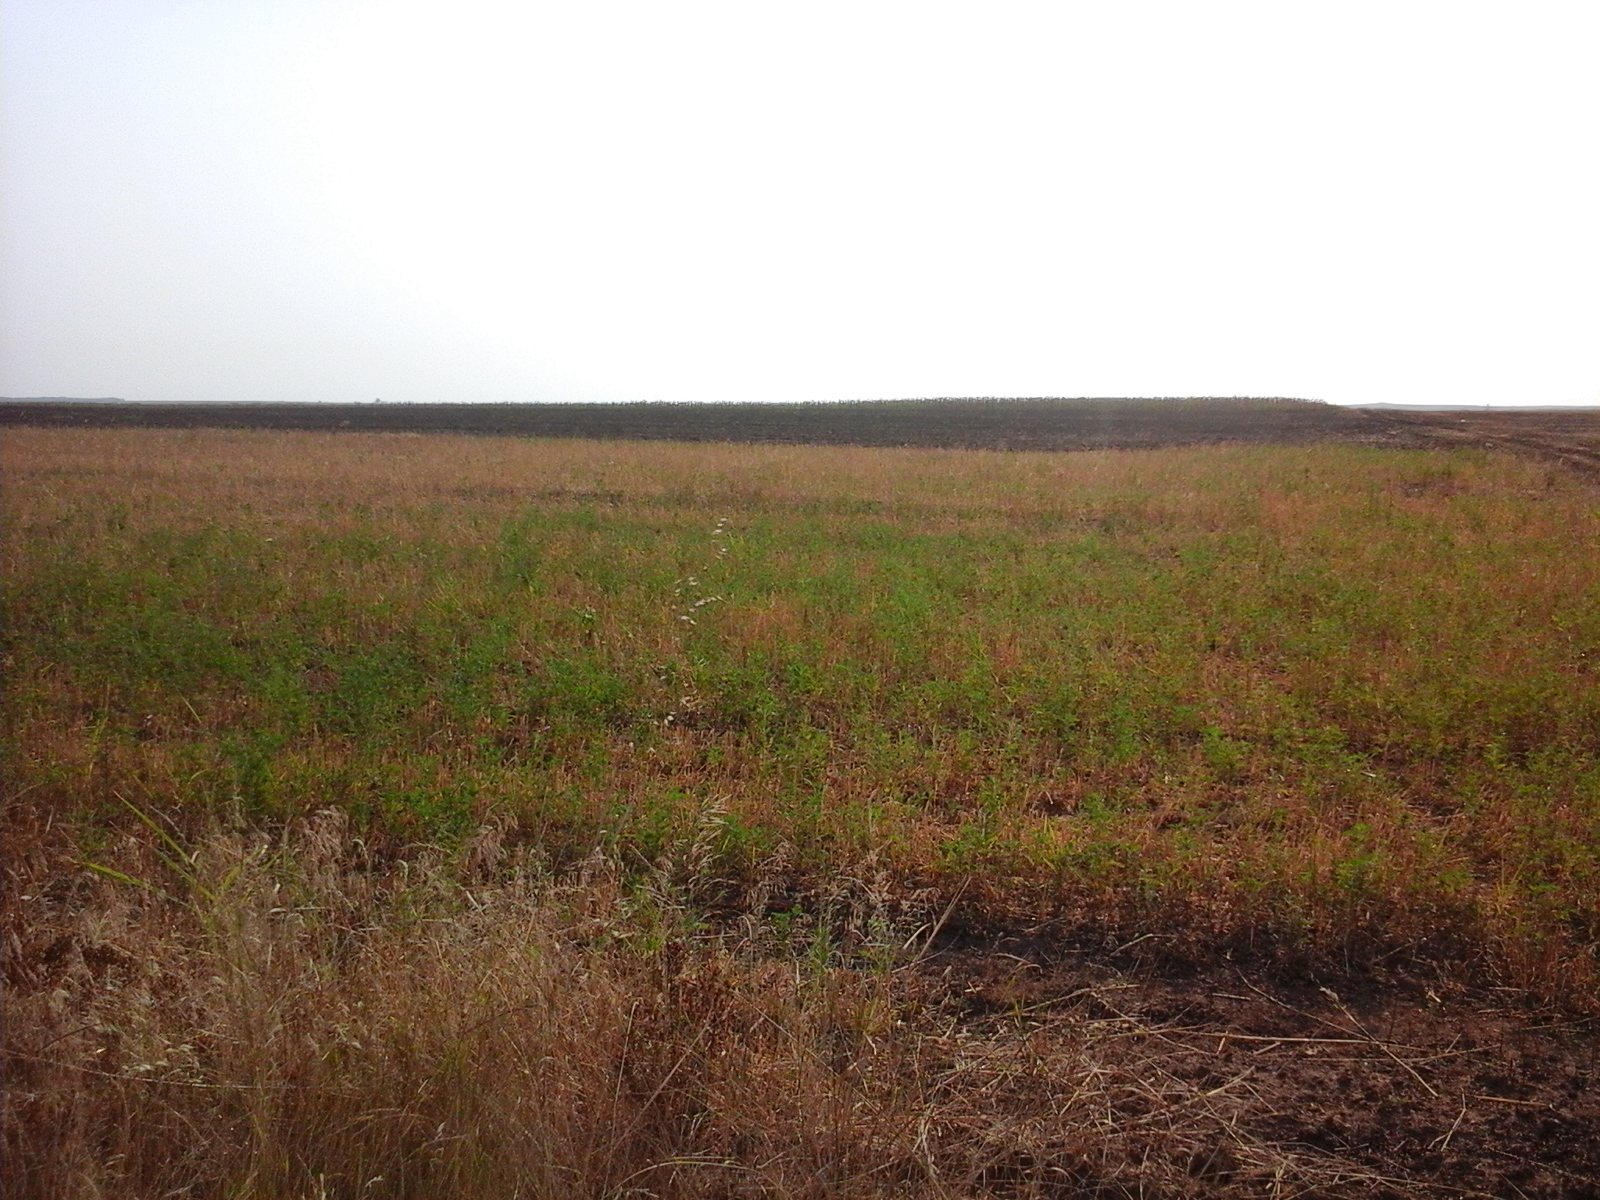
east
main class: Cropland
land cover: Barley
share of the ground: < 10 %
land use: Agriculture (excluding fallow land and kitchen gardens)
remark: Burnt area
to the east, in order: Barley; Common wheat; Barley; Sunflower; Common wheat; Spontaneously vegetated surfaces; Grassland without tree/shrub cover
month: August
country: RO
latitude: 44.2950
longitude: 22.7107
